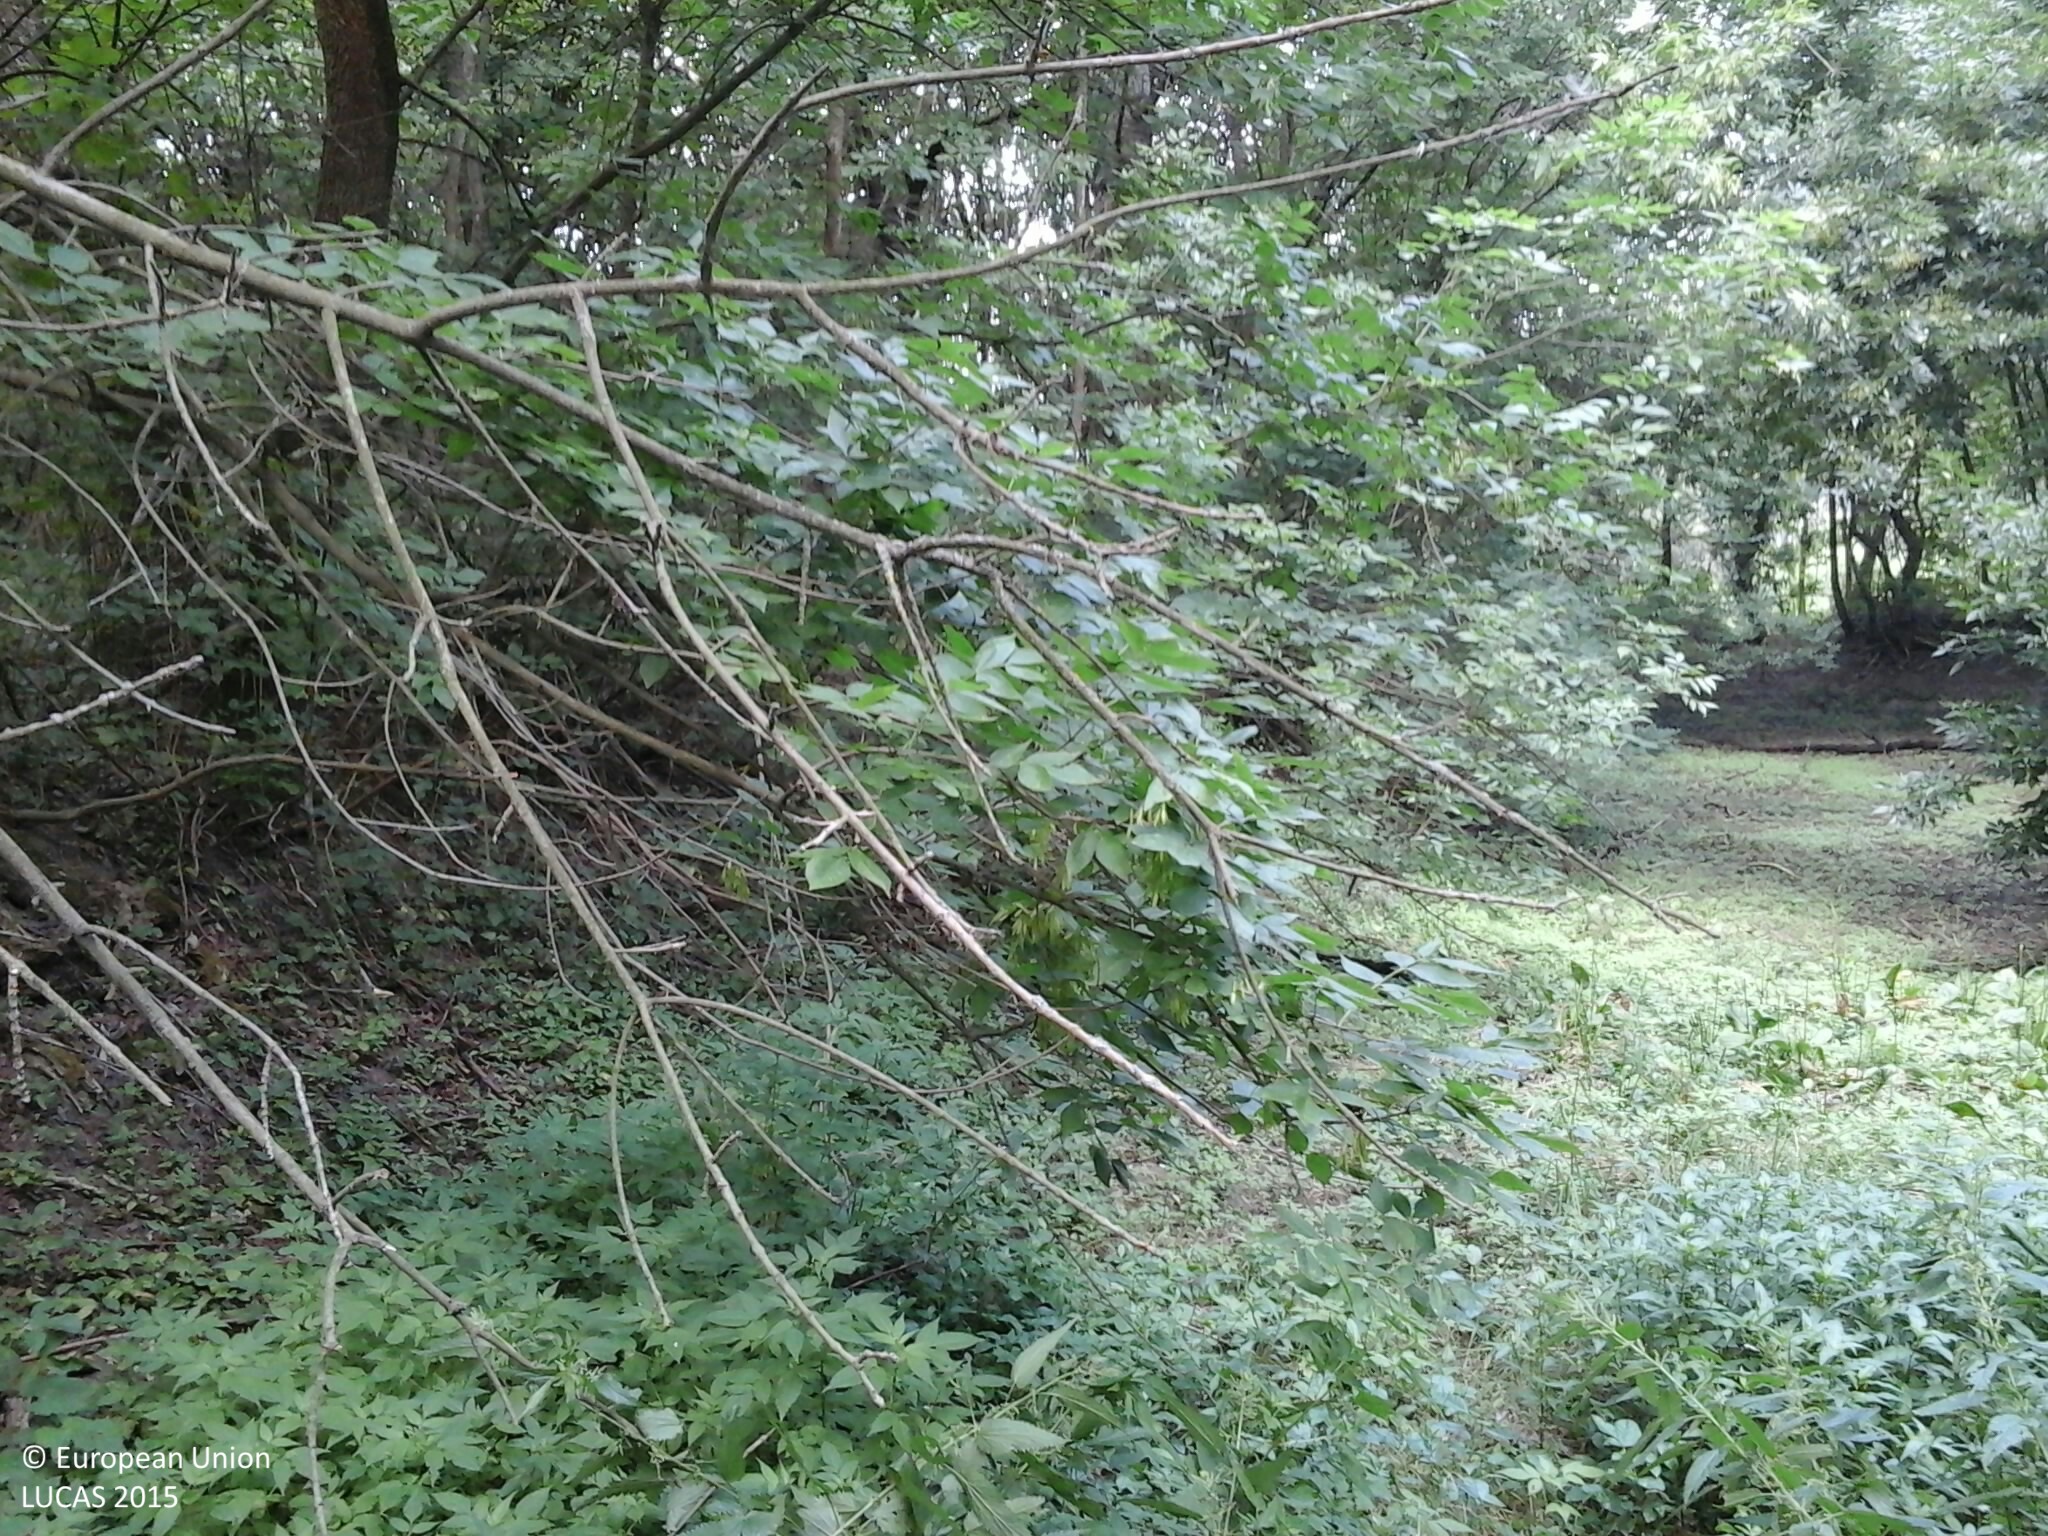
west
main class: Woodland
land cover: Broadleaved woodland
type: mesophytic deciduous forest
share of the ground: > 75 %
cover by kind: broadleaved forest trees 100 %
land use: Forestry
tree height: > 5 m
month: July
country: HU
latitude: 47.7630
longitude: 20.9913
